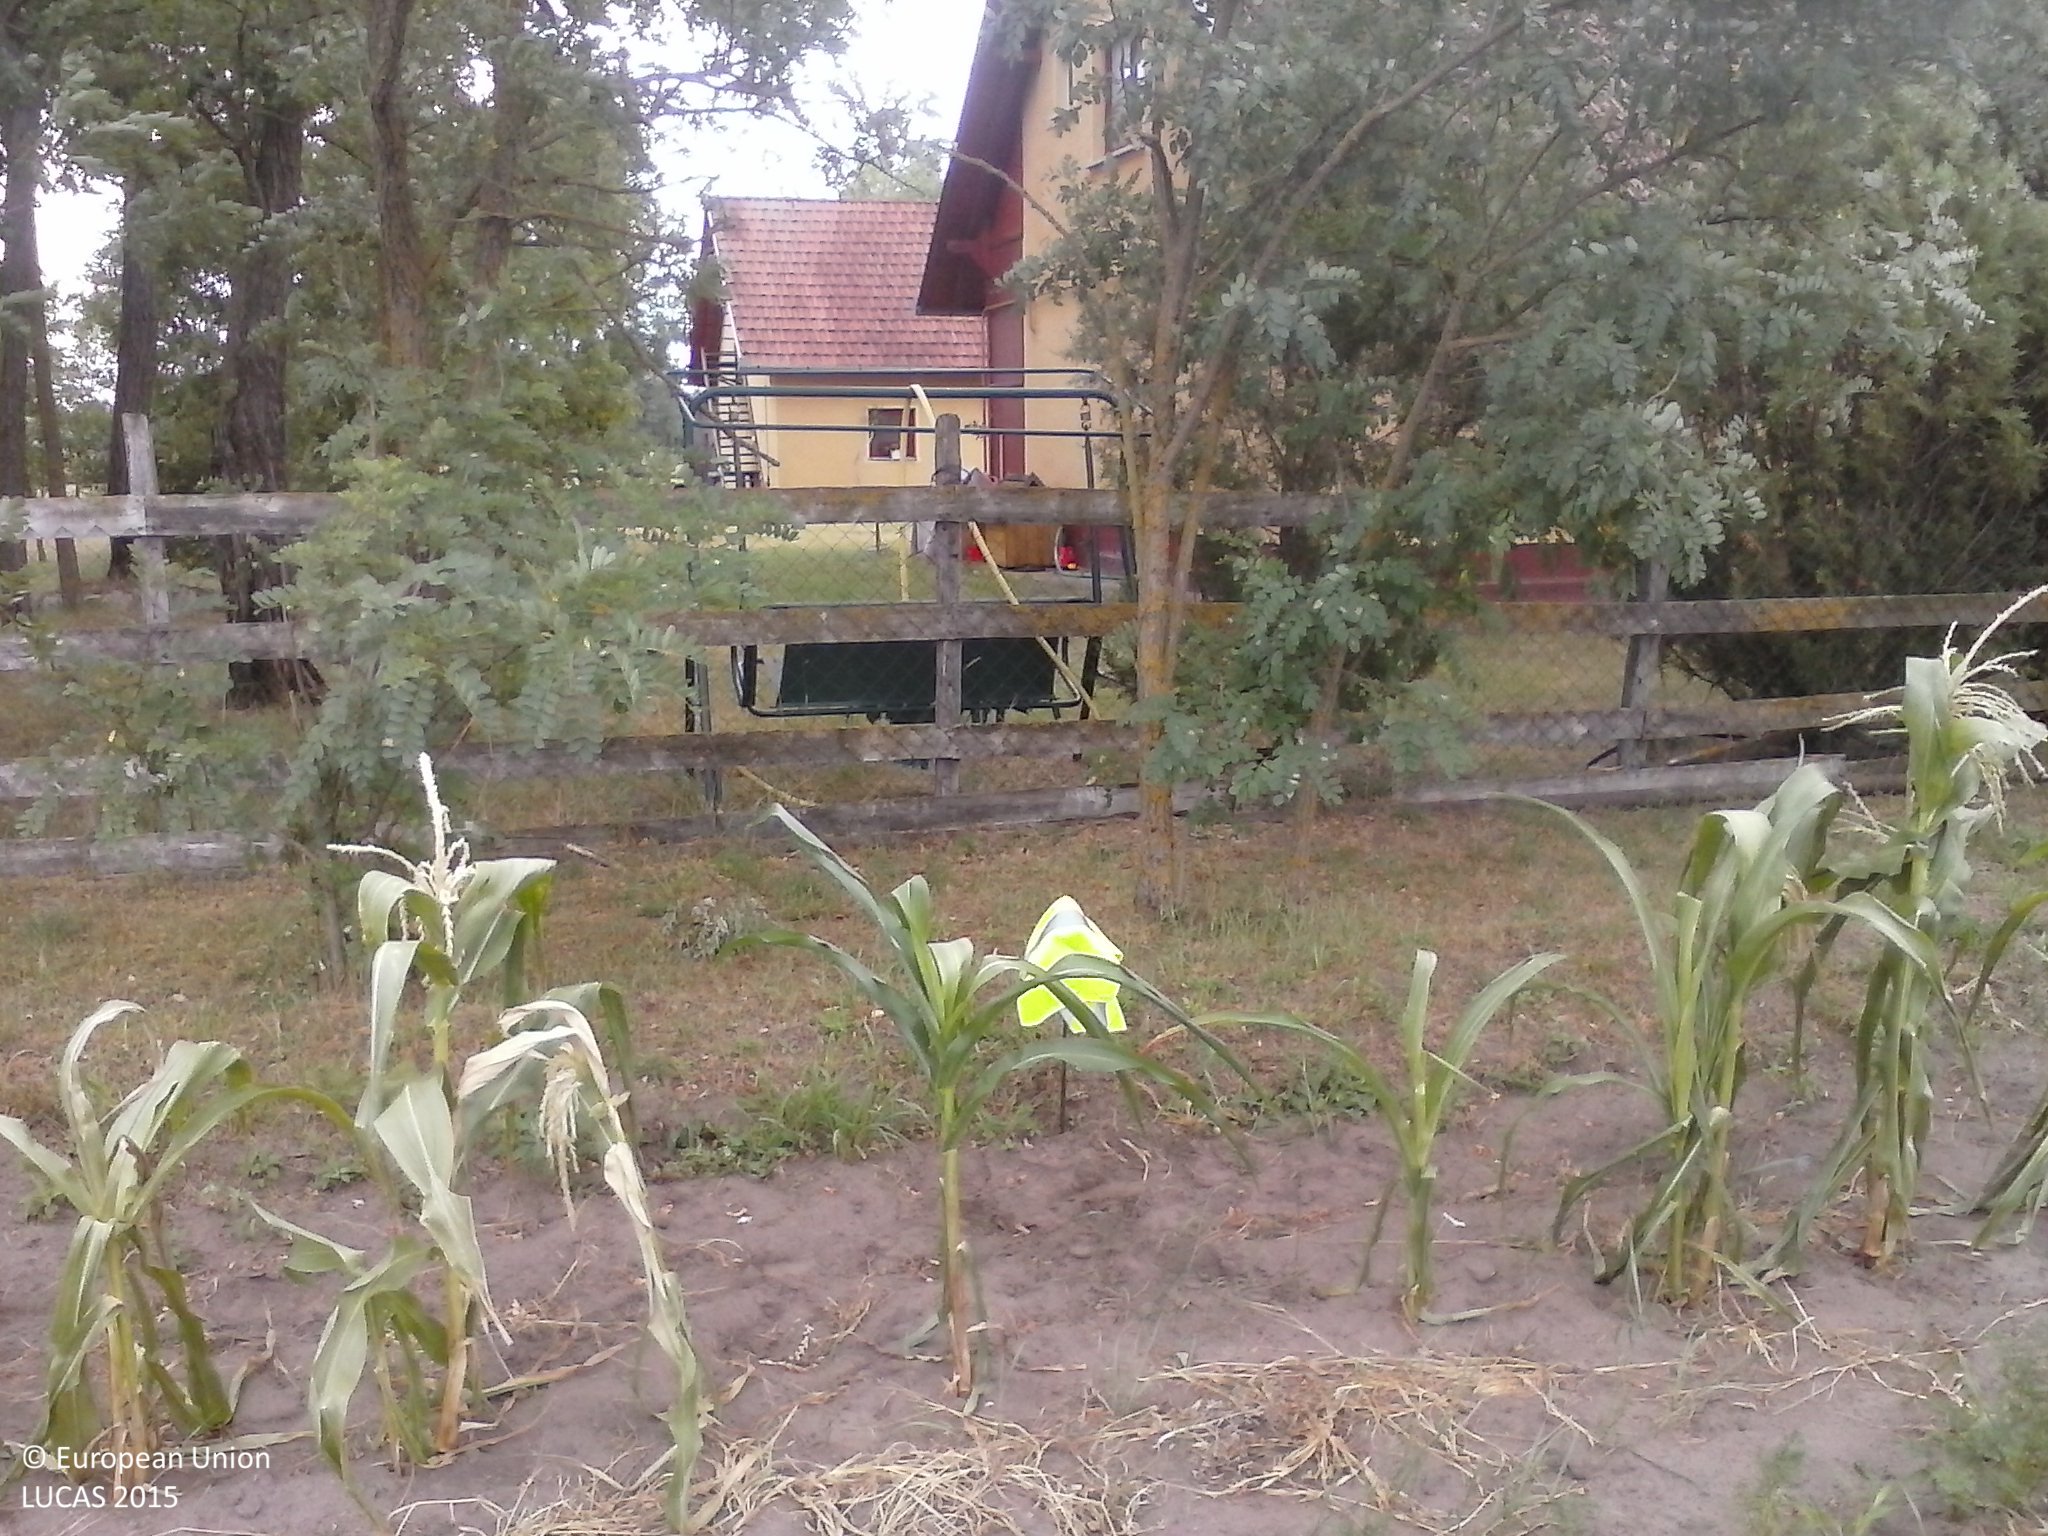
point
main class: Cropland
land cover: Maize
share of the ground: 10 - 25 %
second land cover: Spontaneously vegetated surfaces
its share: > 75 %
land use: Kitchen garden
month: July
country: HU
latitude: 46.5611
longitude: 19.7118
